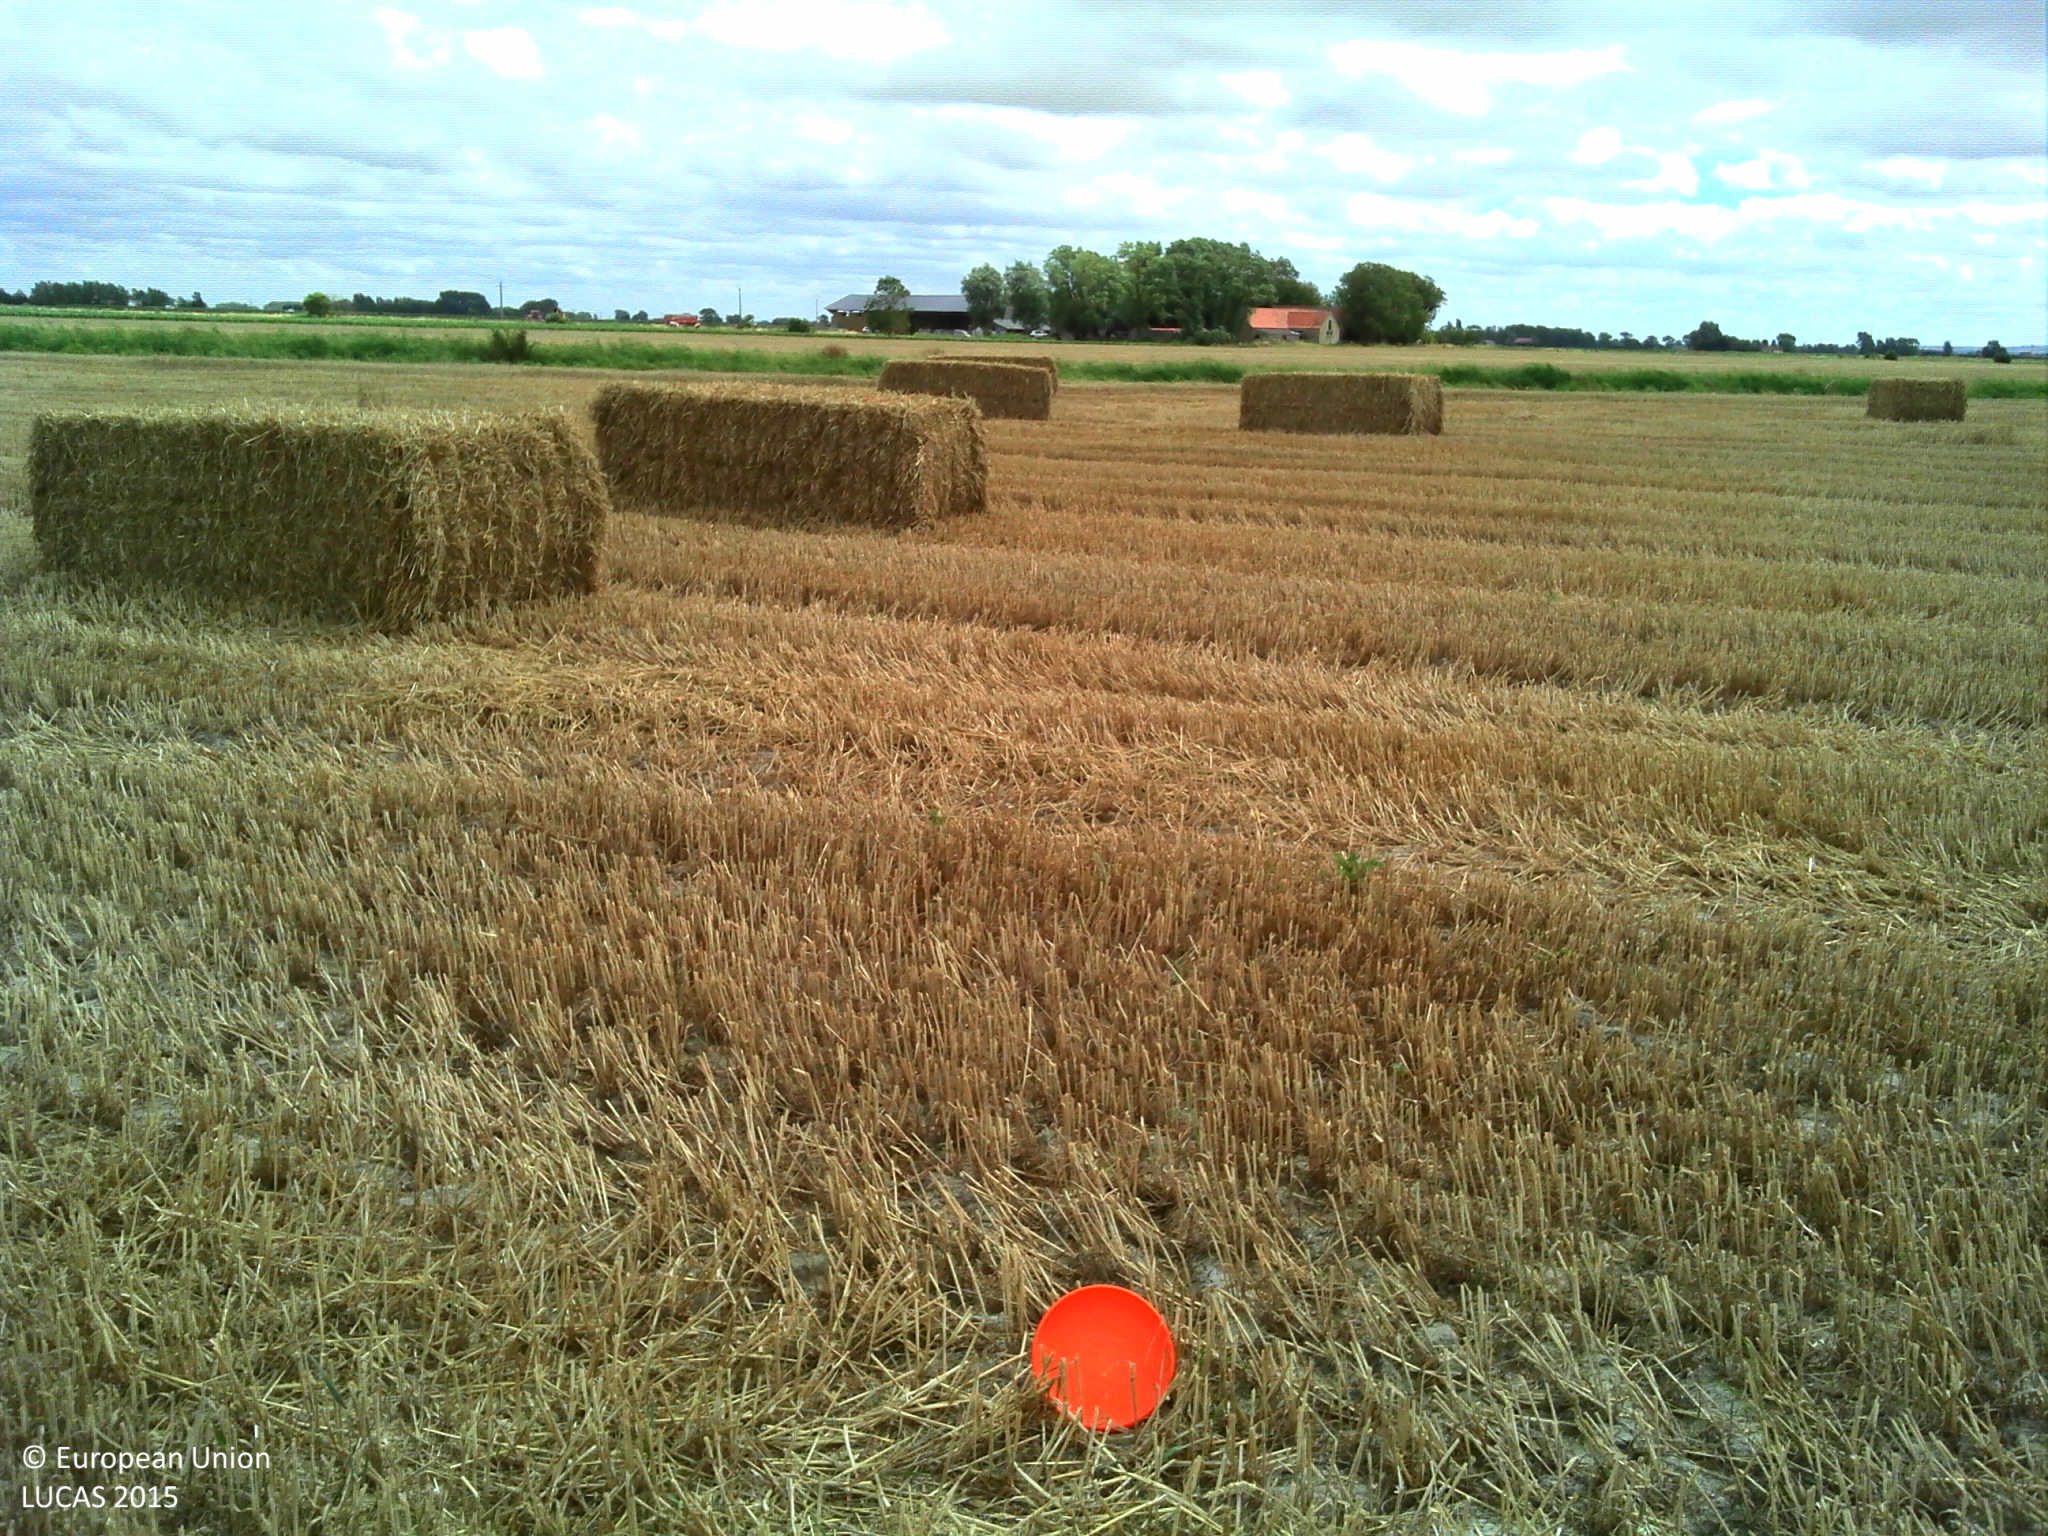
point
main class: Cropland
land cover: Common wheat
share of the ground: 50 - 75 %
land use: Agriculture (excluding fallow land and kitchen gardens)
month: August
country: FR
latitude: 50.9687
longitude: 1.9954
